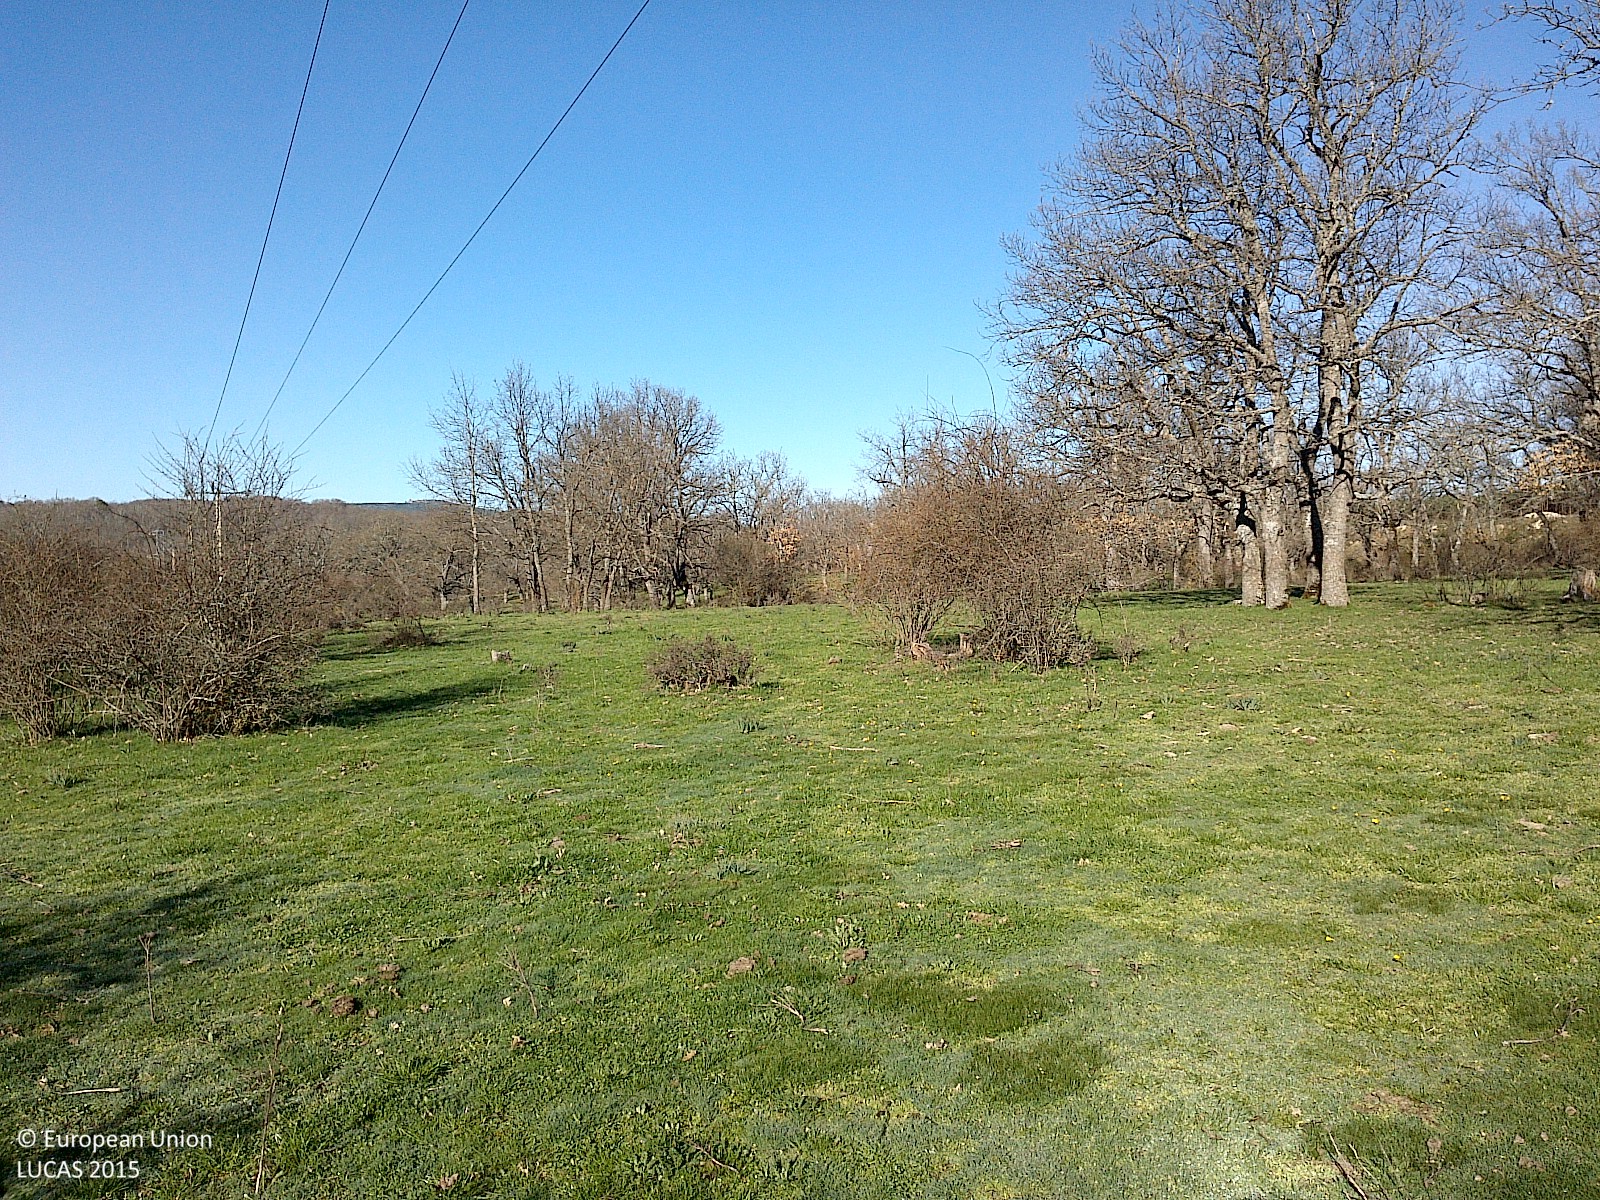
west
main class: Woodland
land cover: Broadleaved woodland
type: thermophilous deciduous forest
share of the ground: 10 - 25 %
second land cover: Spontaneously vegetated surfaces
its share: > 75 %
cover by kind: herbaceous plants 80 %, broadleaved forest trees 10 %, shrubs 10 %
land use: Forestry
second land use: Agriculture (excluding fallow land and kitchen gardens)
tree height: > 5 m
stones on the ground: < 10 %
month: April
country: ES
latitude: 41.9648
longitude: -3.0913
